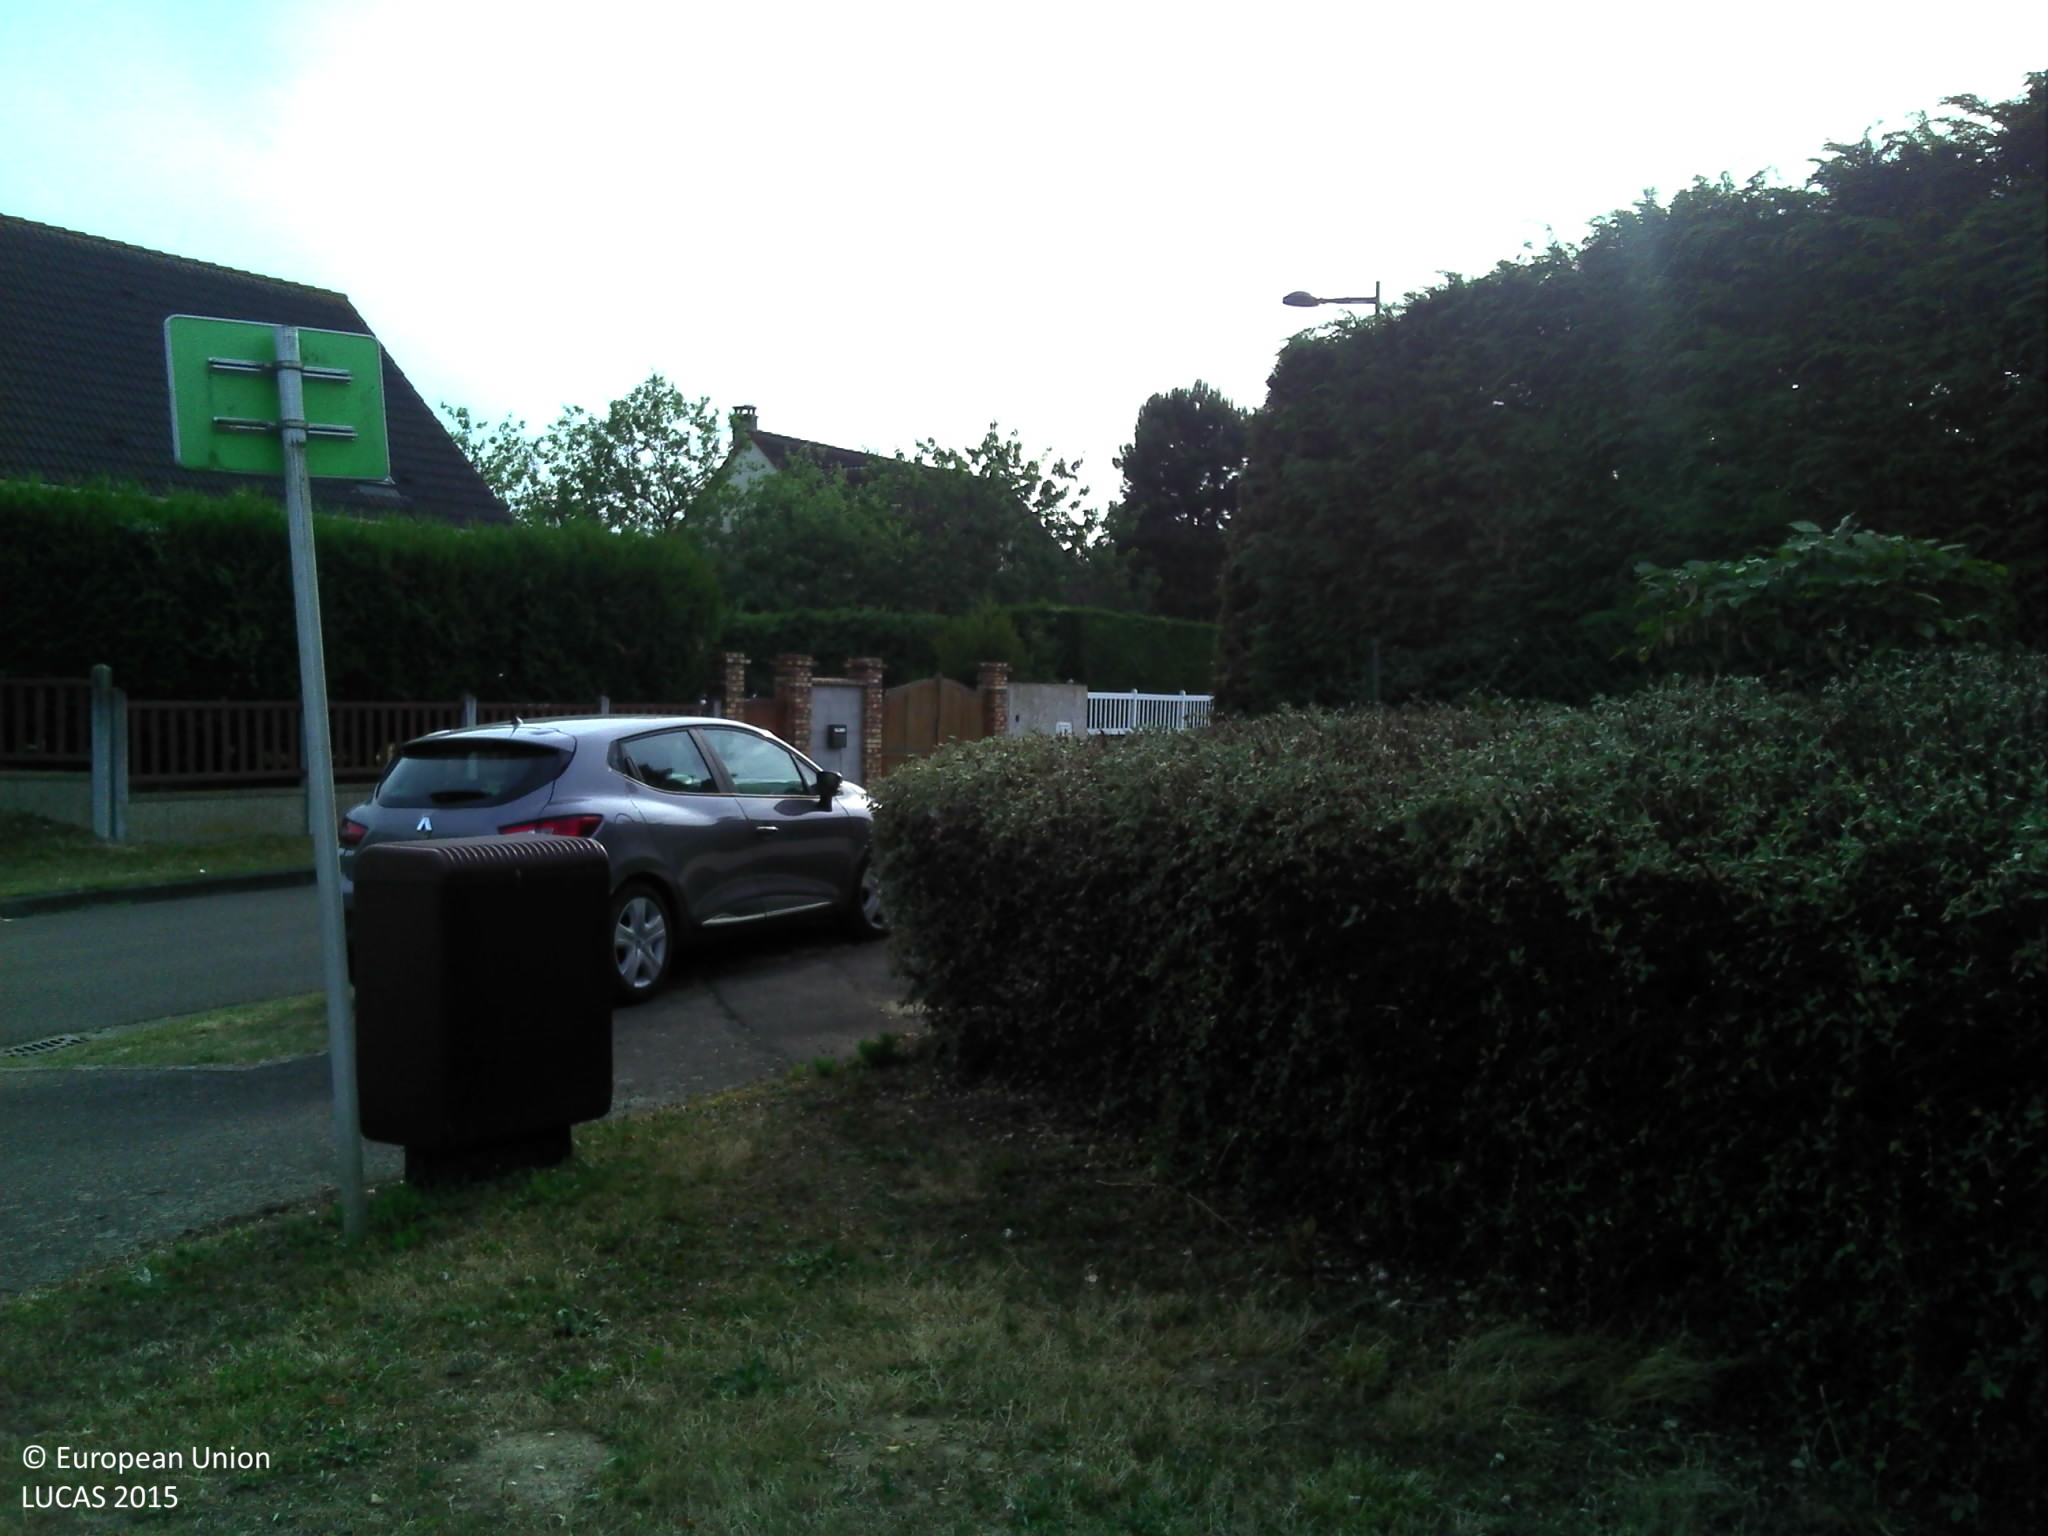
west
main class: Grassland
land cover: Grassland without tree/shrub cover
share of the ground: > 75 %
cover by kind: herbaceous plants 100 %
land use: Semi-natural and natural areas not in use
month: June
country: FR
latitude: 49.2665
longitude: 1.2258
